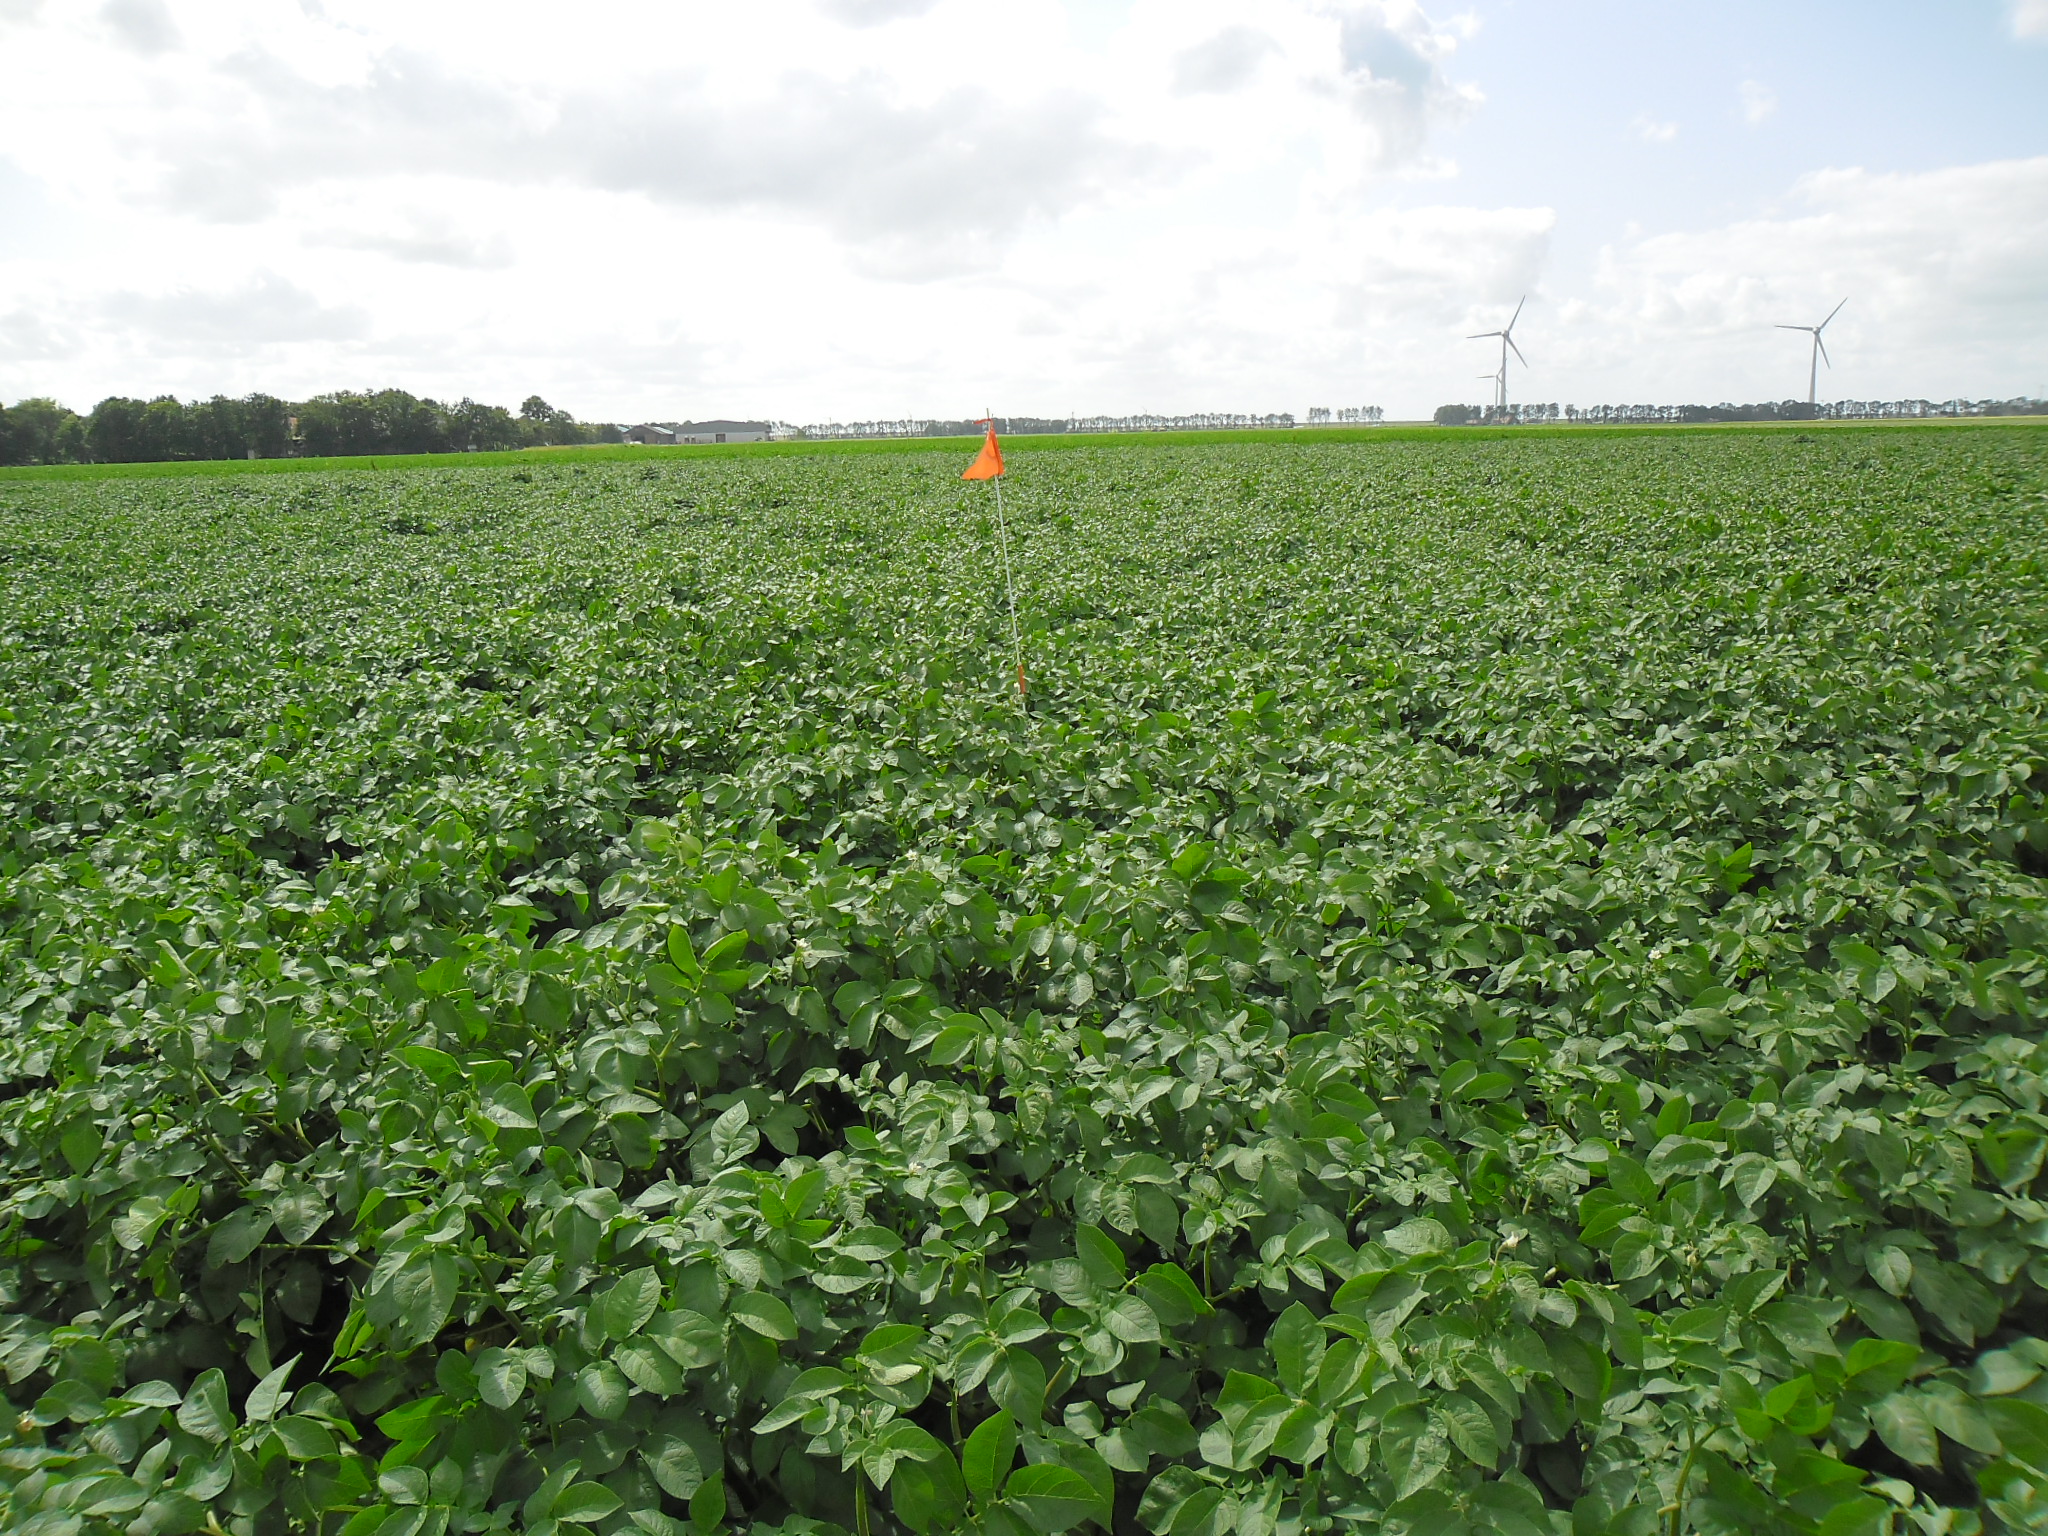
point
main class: Cropland
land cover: Potatoes
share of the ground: > 75 %
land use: Agriculture (excluding fallow land and kitchen gardens)
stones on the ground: < 10 %
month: July
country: NL
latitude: 52.7112
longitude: 5.6322
